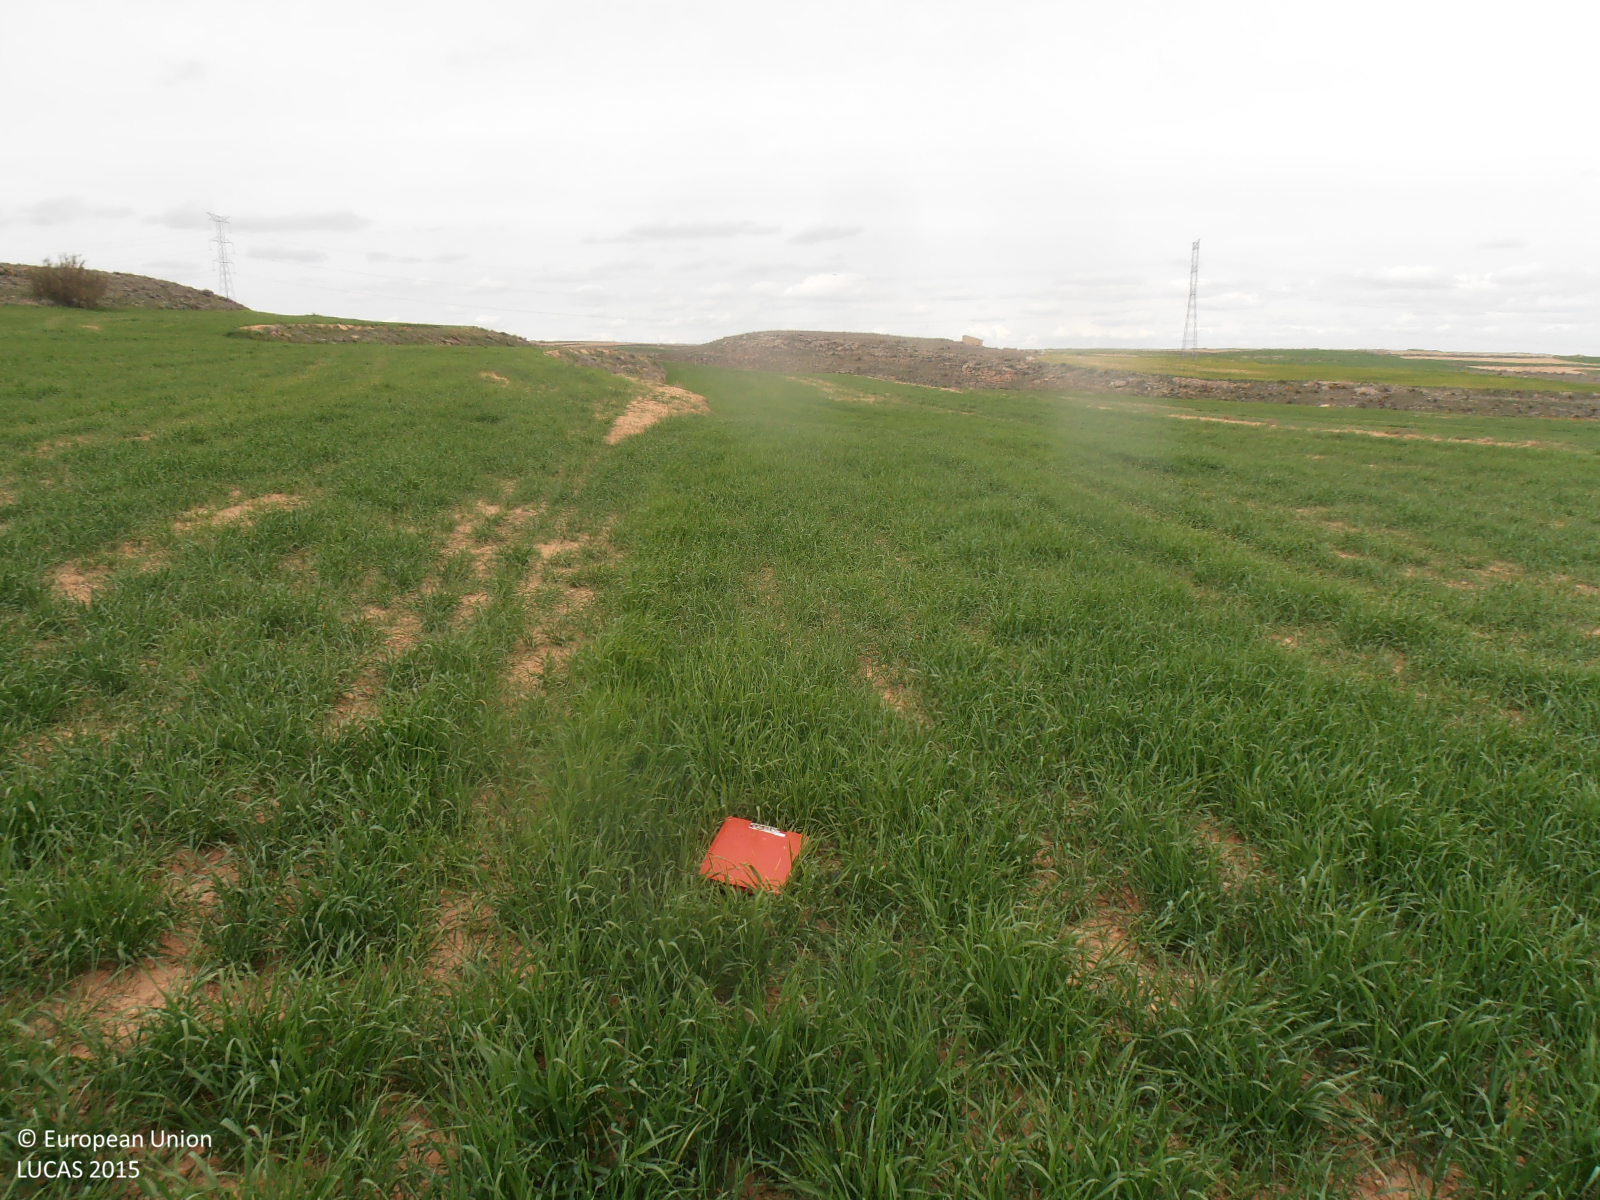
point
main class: Cropland
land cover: Barley
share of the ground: > 75 %
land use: Agriculture (excluding fallow land and kitchen gardens)
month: April
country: ES
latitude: 41.1715
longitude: -0.8999
